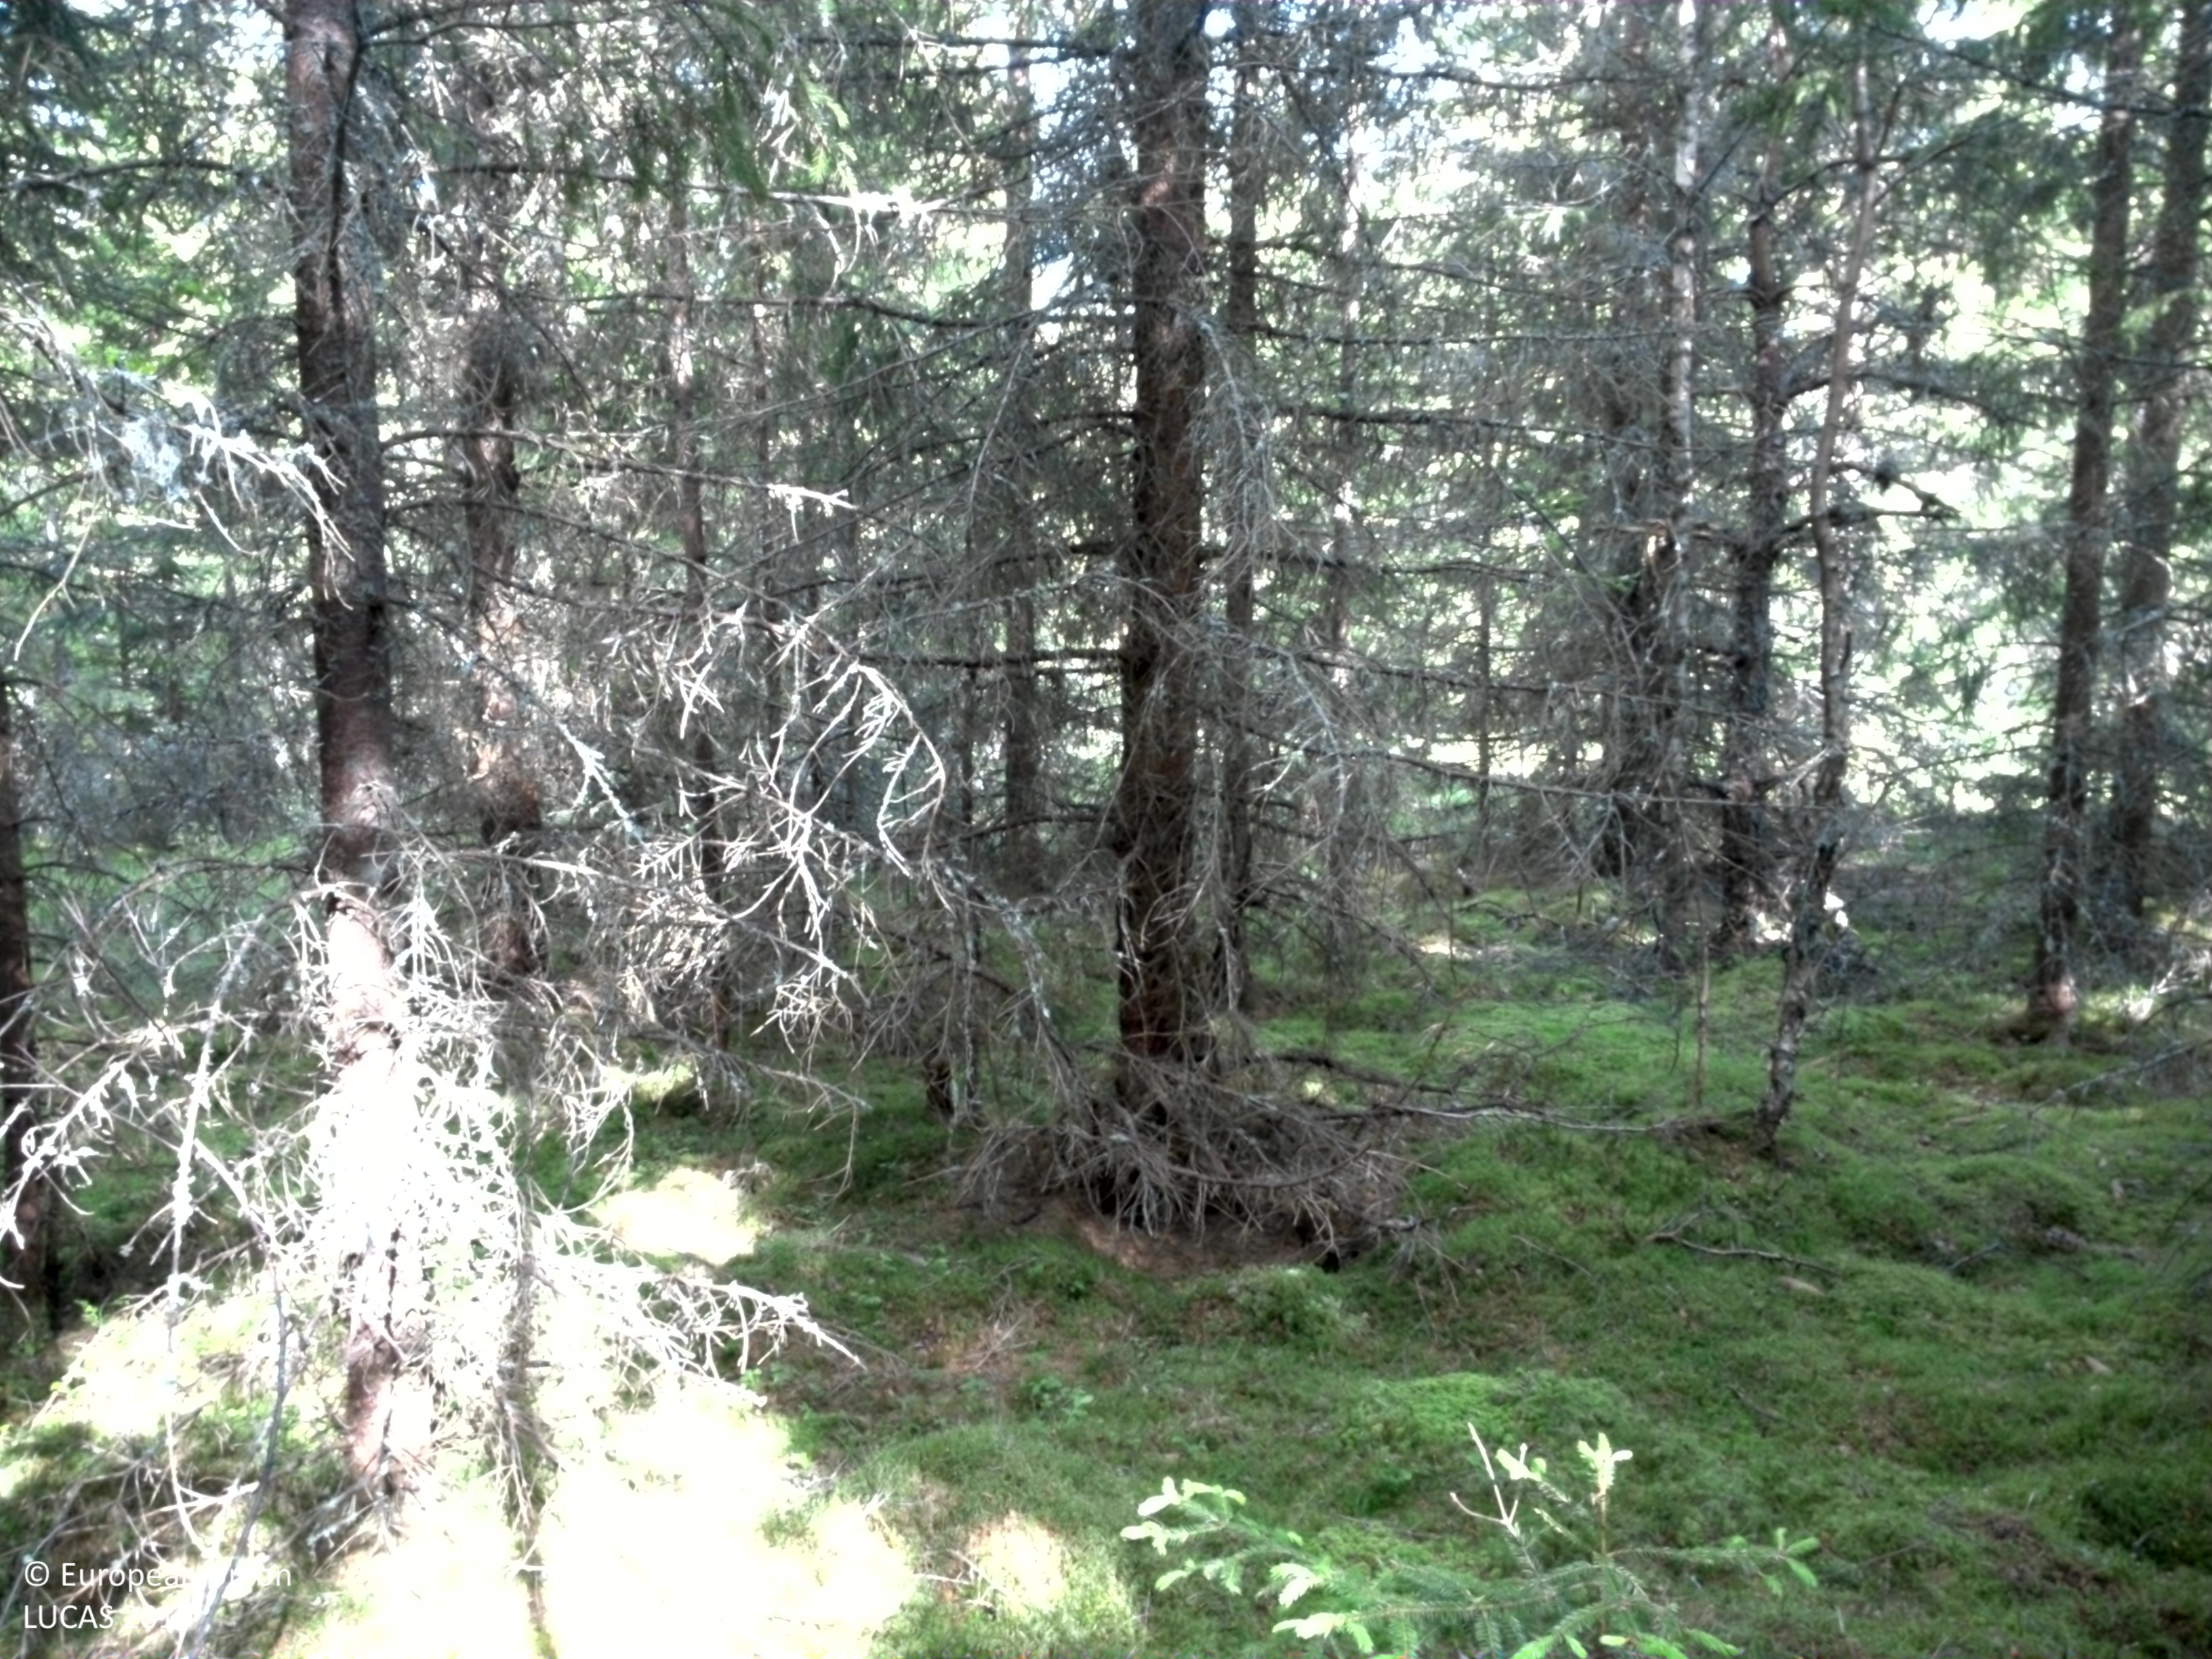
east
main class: Woodland
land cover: Spruce dominated coniferous woodland
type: boreal forest
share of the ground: > 75 %
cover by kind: coniferous forest trees 75 %, lichens and mosses 15 %, broadleaved forest trees 5 %, herbaceous plants 5 %
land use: Forestry
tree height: > 5 m
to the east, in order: Spruce dominated coniferous woodland; Tracks; Spruce dominated coniferous woodland; Spruce dominated mixed woodland; Tracks; Spruce dominated mixed woodland; Spruce dominated coniferous woodland; Ditches and canals; Spruce dominated coniferous woodland
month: June
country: SE
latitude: 59.5778
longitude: 14.1871
